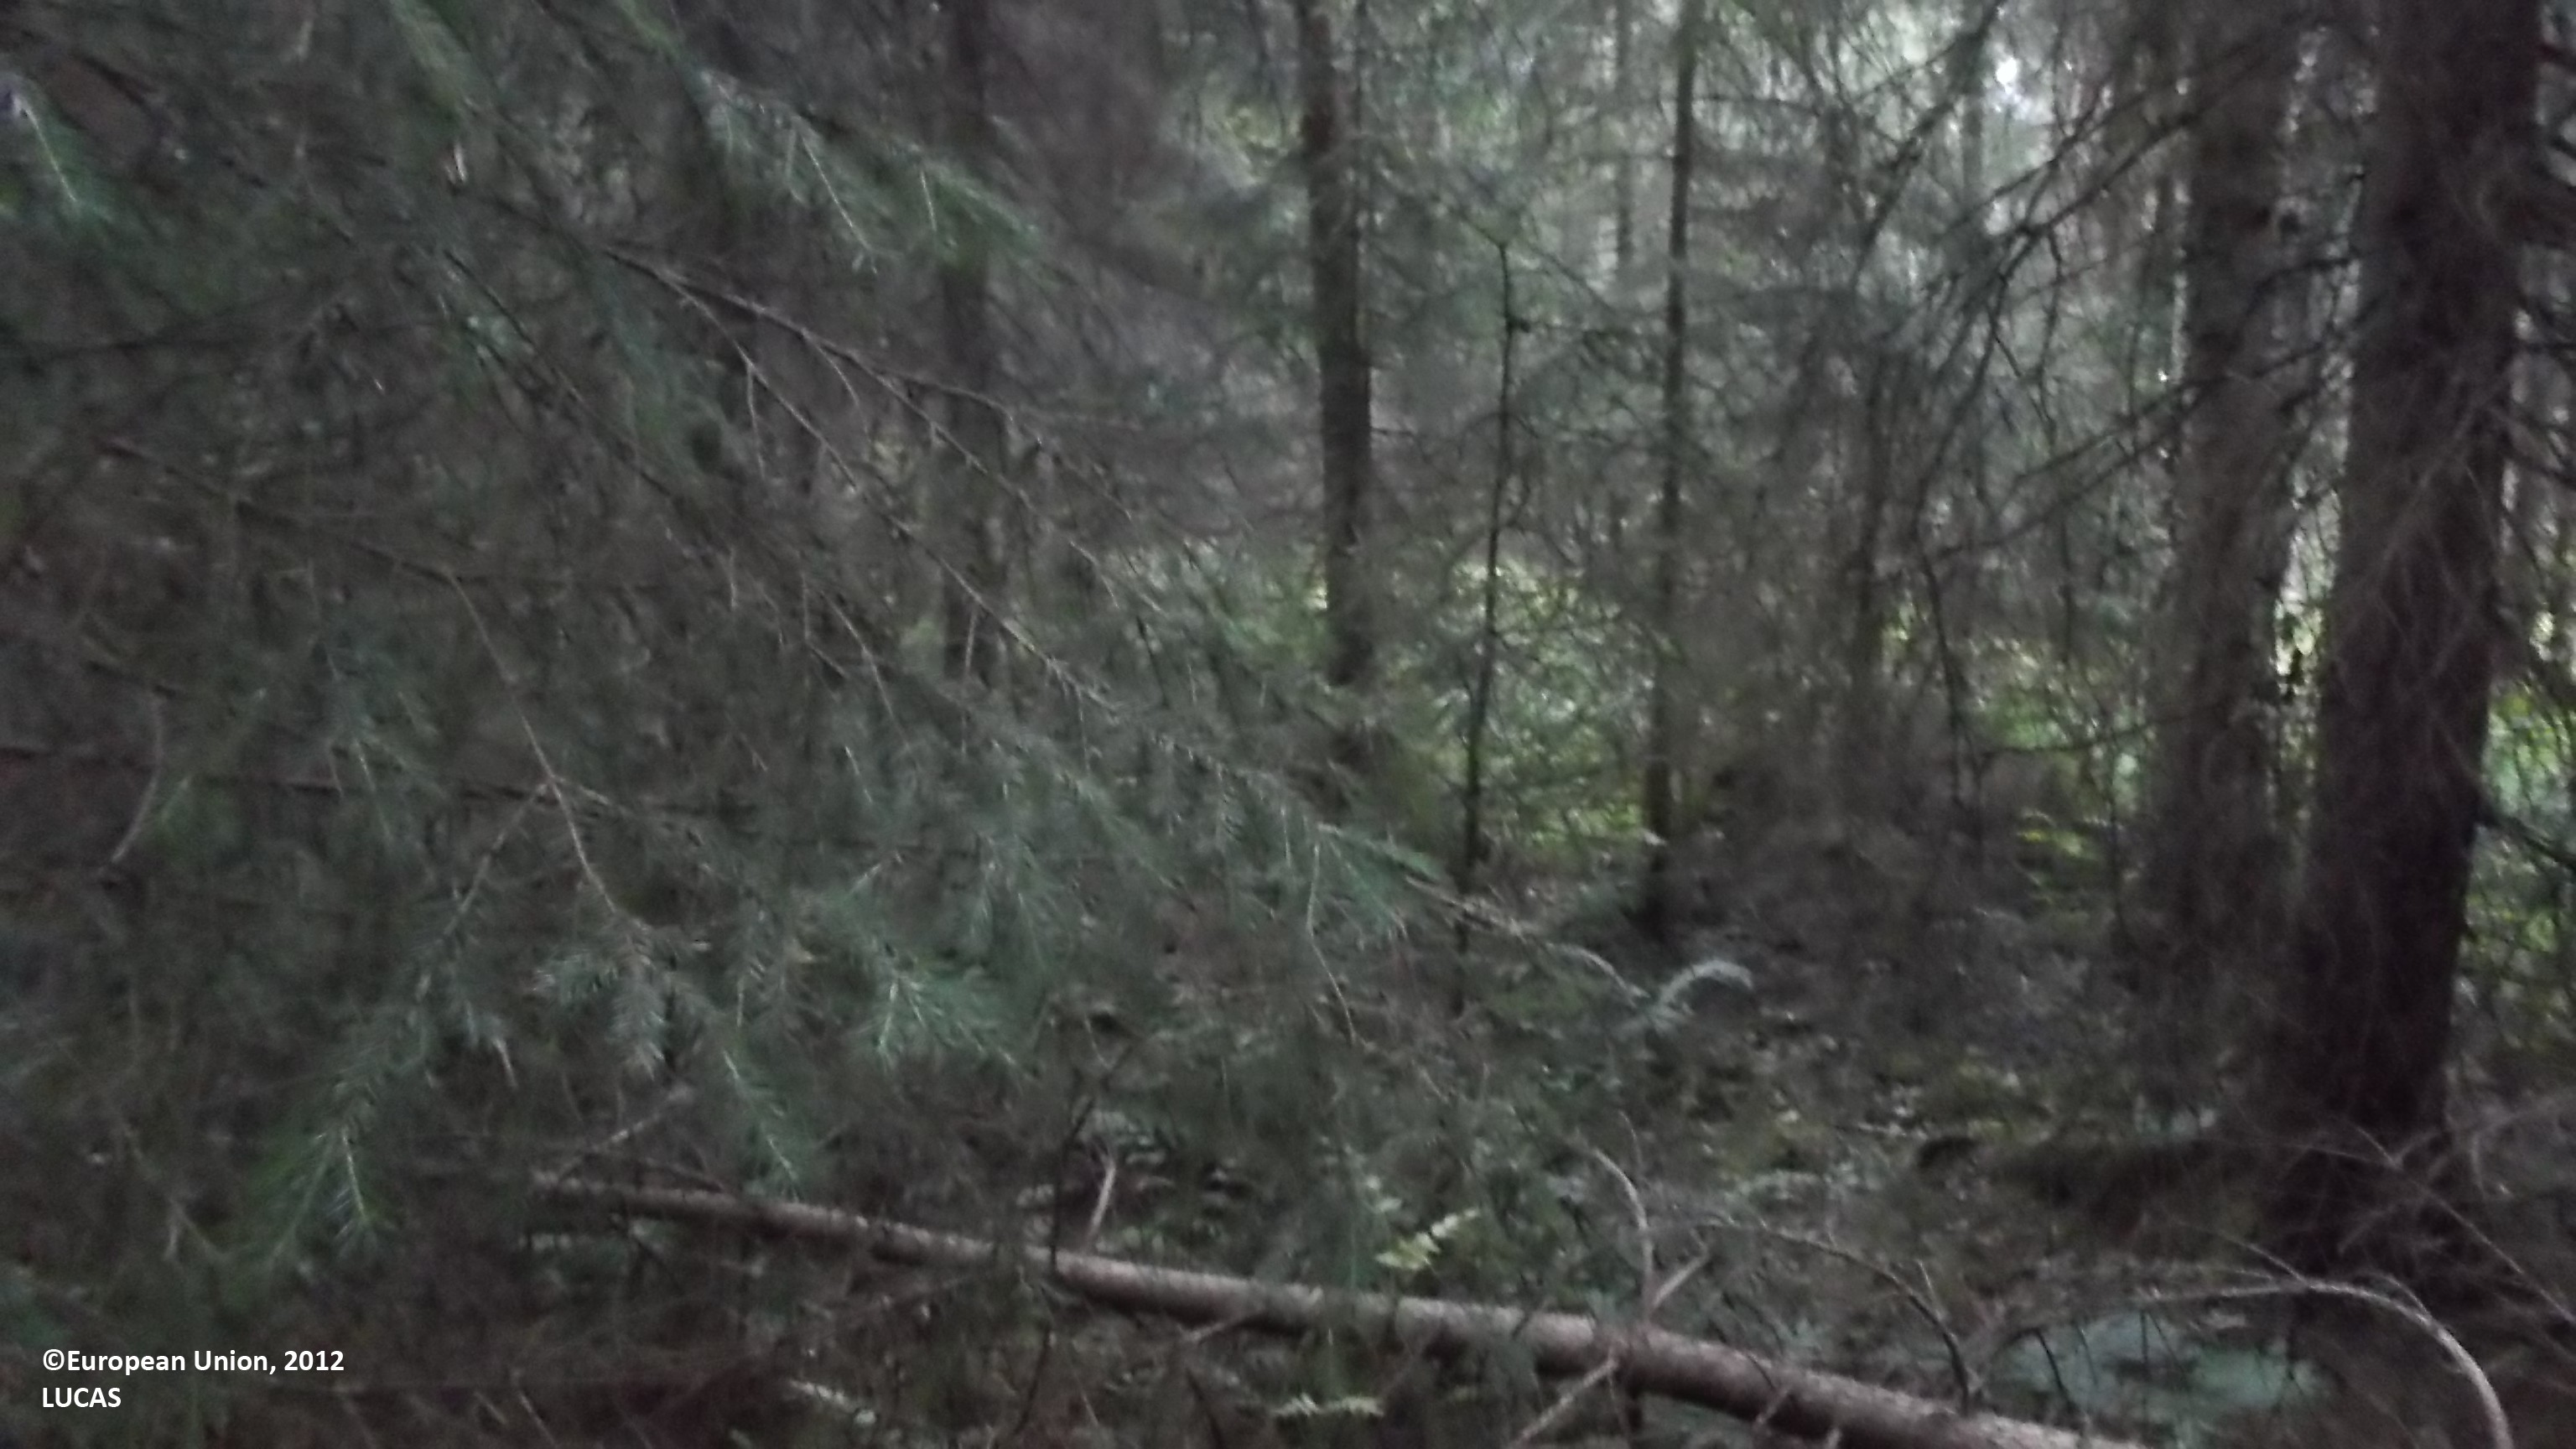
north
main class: Woodland
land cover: Spruce dominated coniferous woodland
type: boreal forest
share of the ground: > 75 %
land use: Forestry
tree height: > 5 m
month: July
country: FI
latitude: 63.6530
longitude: 23.2853
